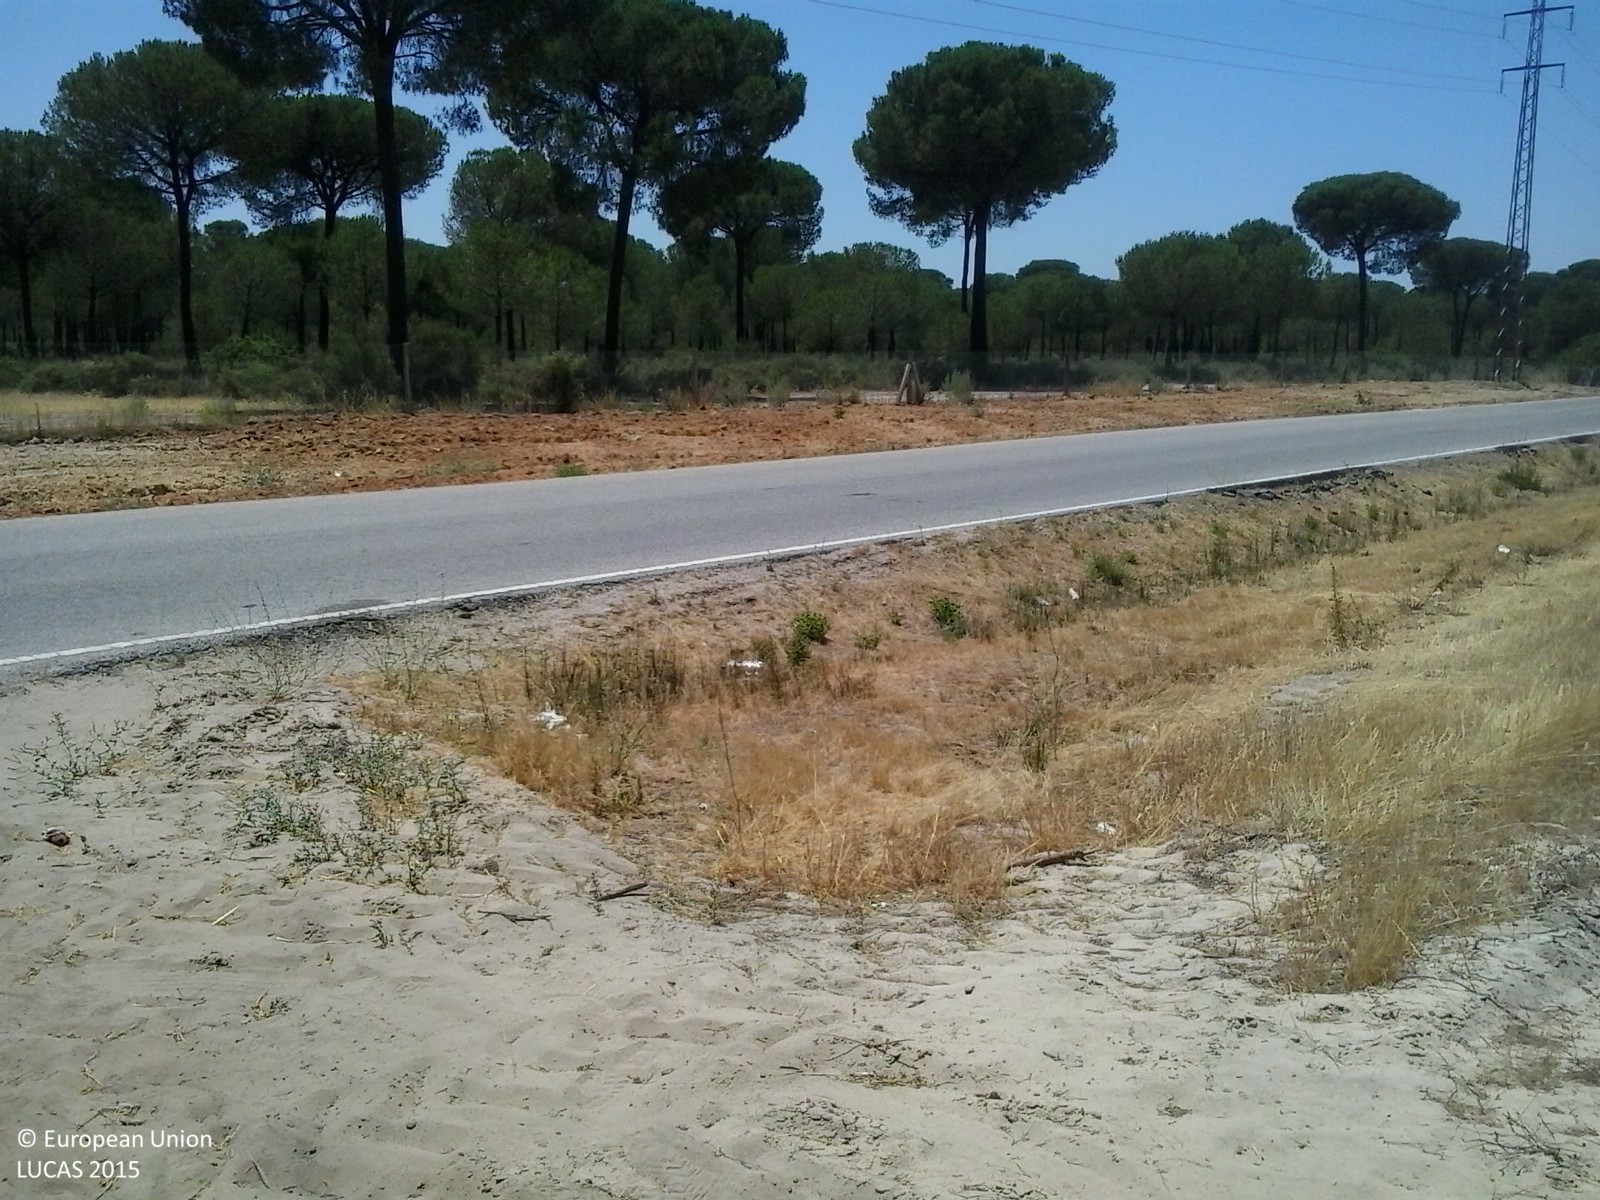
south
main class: Woodland
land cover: Pine dominated coniferous woodland
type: coniferous forest of the mediterranean region
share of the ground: 50 - 75 %
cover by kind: coniferous forest trees 50 %, herbaceous plants 30 %, shrubs 20 %
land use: Forestry
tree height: > 5 m
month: July
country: ES
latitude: 37.2034
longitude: -6.3751
